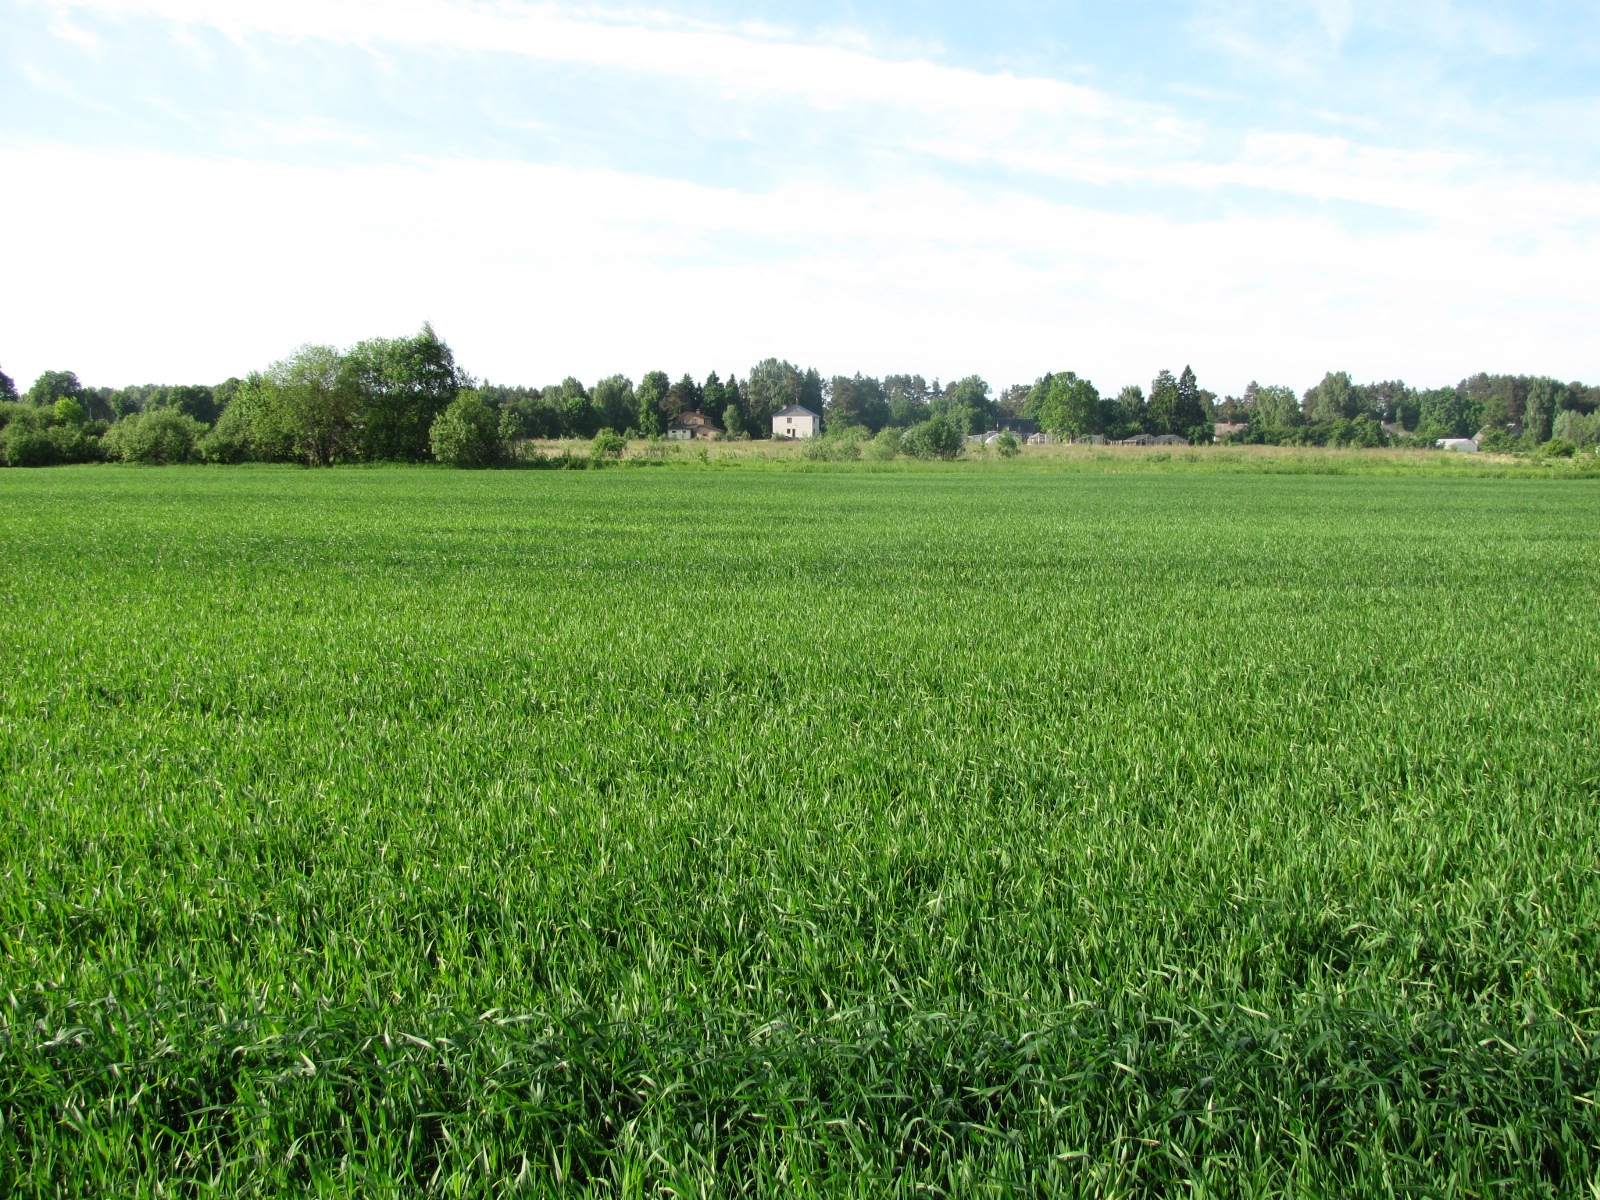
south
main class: Cropland
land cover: Common wheat
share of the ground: > 75 %
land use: Agriculture (excluding fallow land and kitchen gardens)
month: June
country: LV
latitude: 56.8305
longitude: 24.2651
